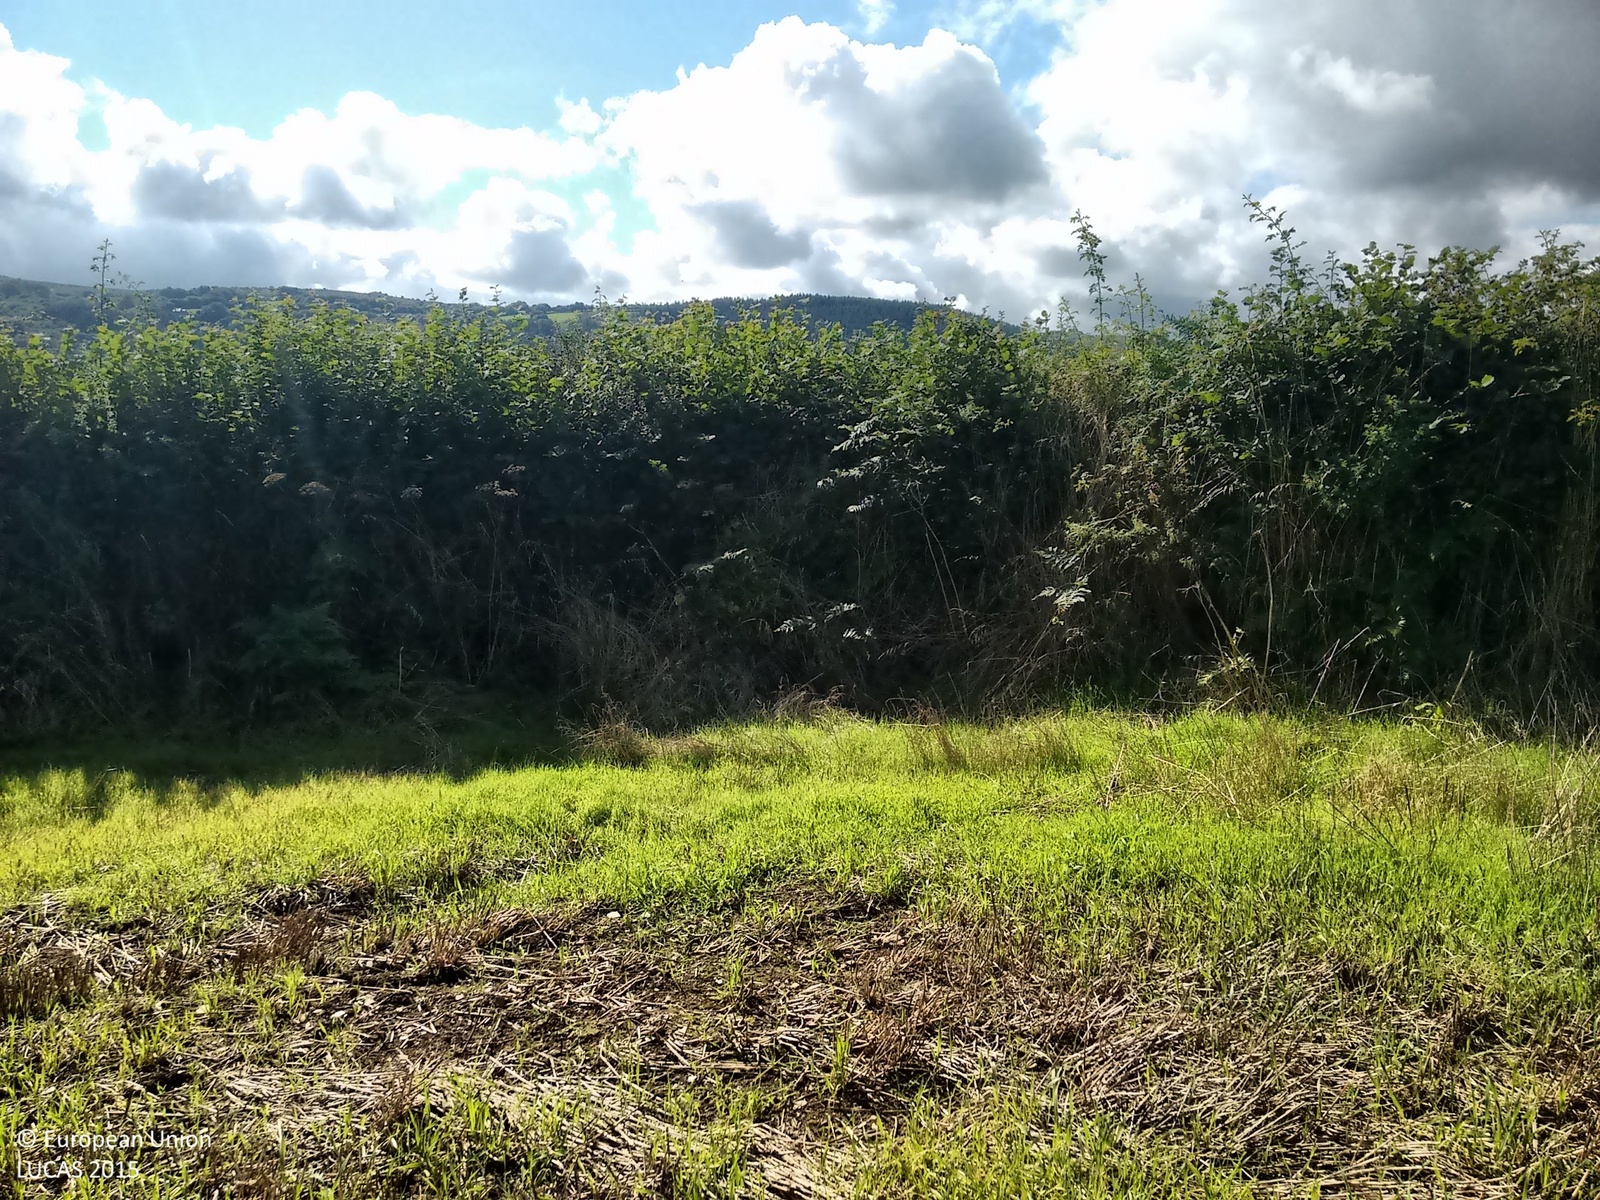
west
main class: Cropland
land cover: Common wheat
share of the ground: 10 - 25 %
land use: Agriculture (excluding fallow land and kitchen gardens)
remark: Harvested field
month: September
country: GB
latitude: 50.5573
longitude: -4.4301
